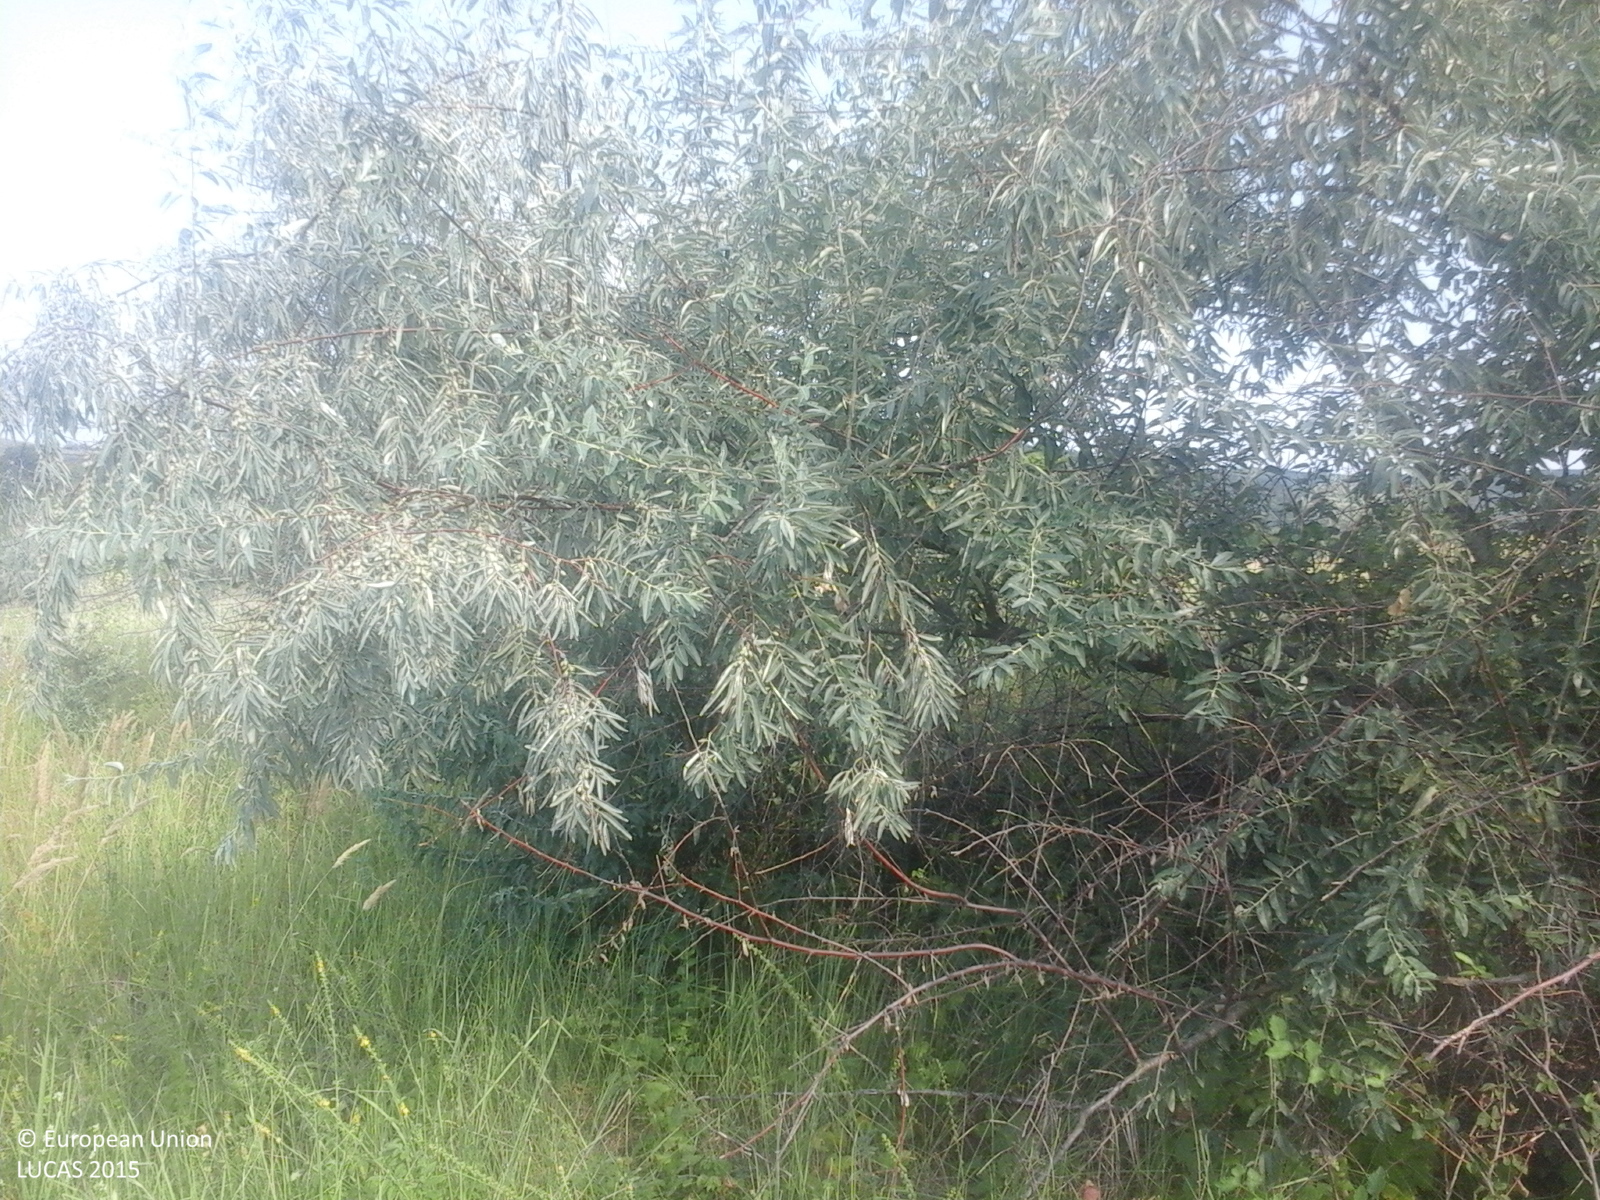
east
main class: Grassland
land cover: Grassland with sparse tree/shrub cover
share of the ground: > 75 %
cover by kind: herbaceous plants 85 %, shrubs 10 %, broadleaved forest trees 5 %
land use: Agriculture (excluding fallow land and kitchen gardens)
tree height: < 5 m
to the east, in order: Grassland with sparse tree/shrub cover; Abandoned hedges; Tracks; Grassland with sparse tree/shrub cover; Tracks; Shruby margins; Lucerne; Shrubland with sparse tree cover
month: July
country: RO
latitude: 45.2647
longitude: 28.3384
